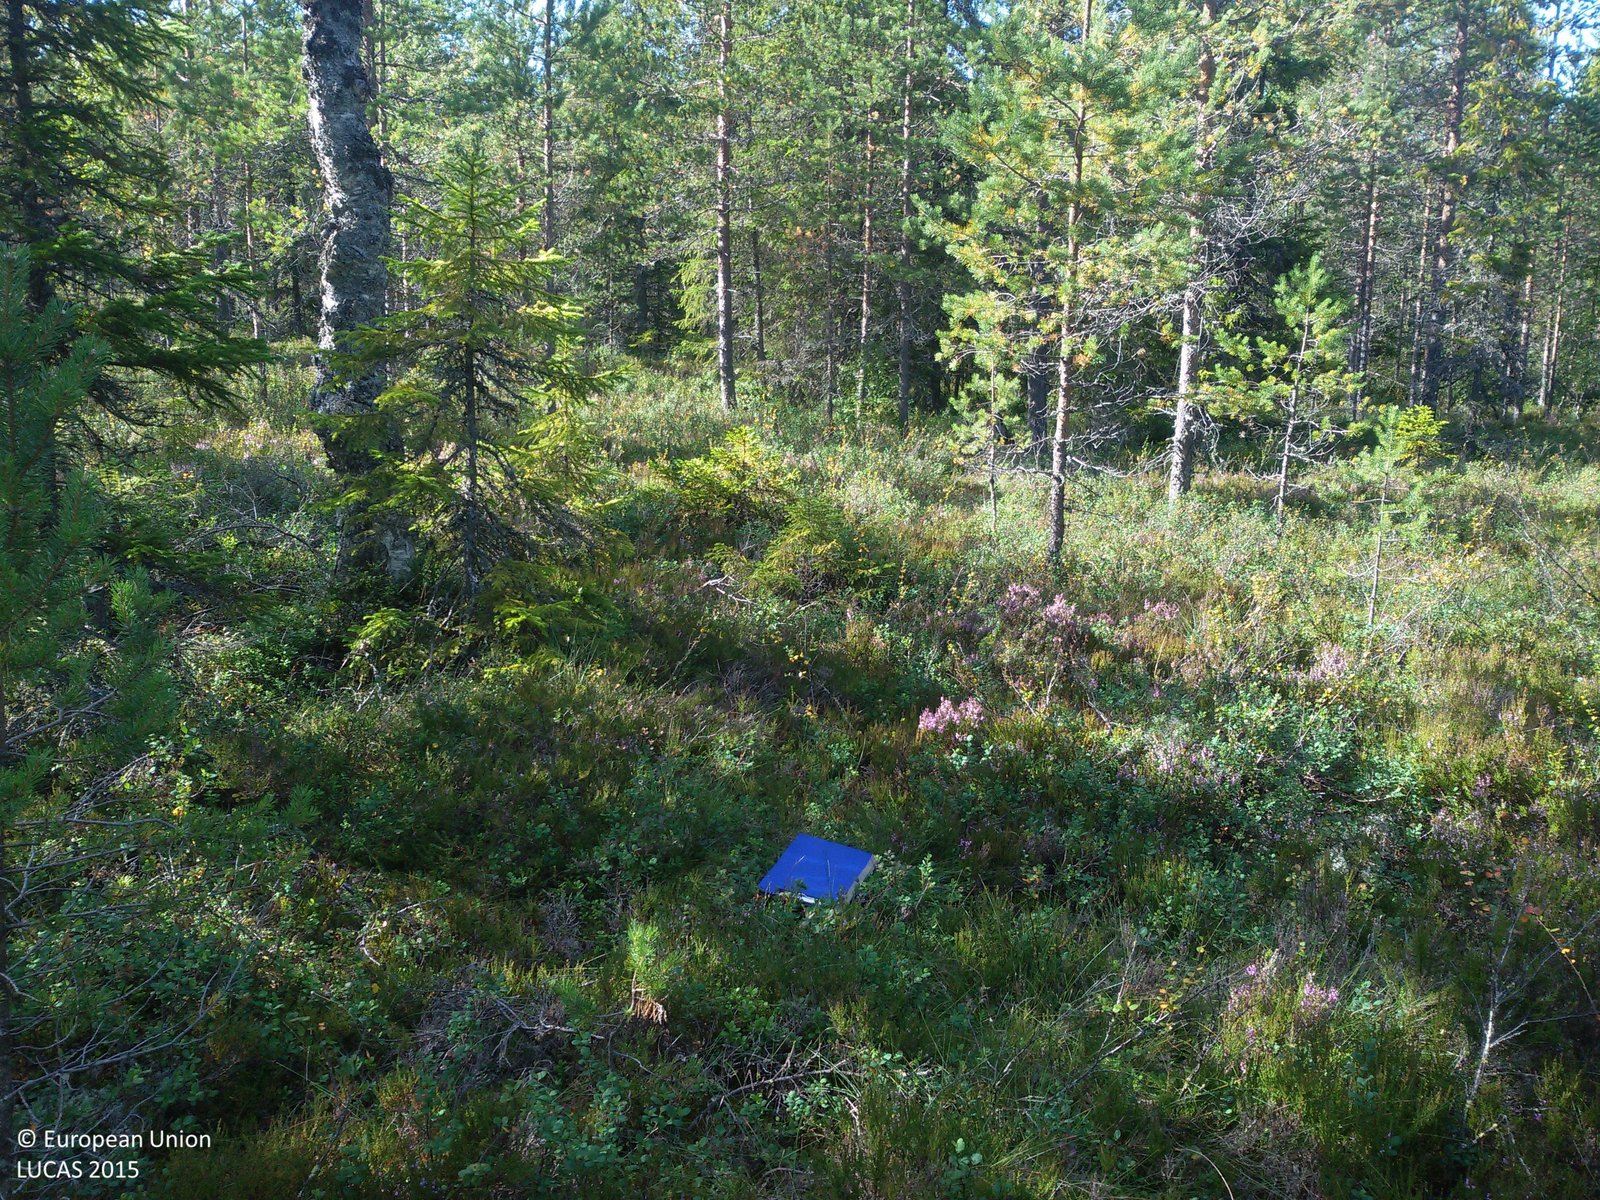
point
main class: Woodland
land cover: Pine dominated coniferous woodland
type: boreal forest
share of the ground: 50 - 75 %
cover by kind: coniferous forest trees 50 %, herbaceous plants 40 %, lichens and mosses 10 %
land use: Forestry
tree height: > 5 m
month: August
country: SE
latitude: 60.9224
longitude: 15.9443
